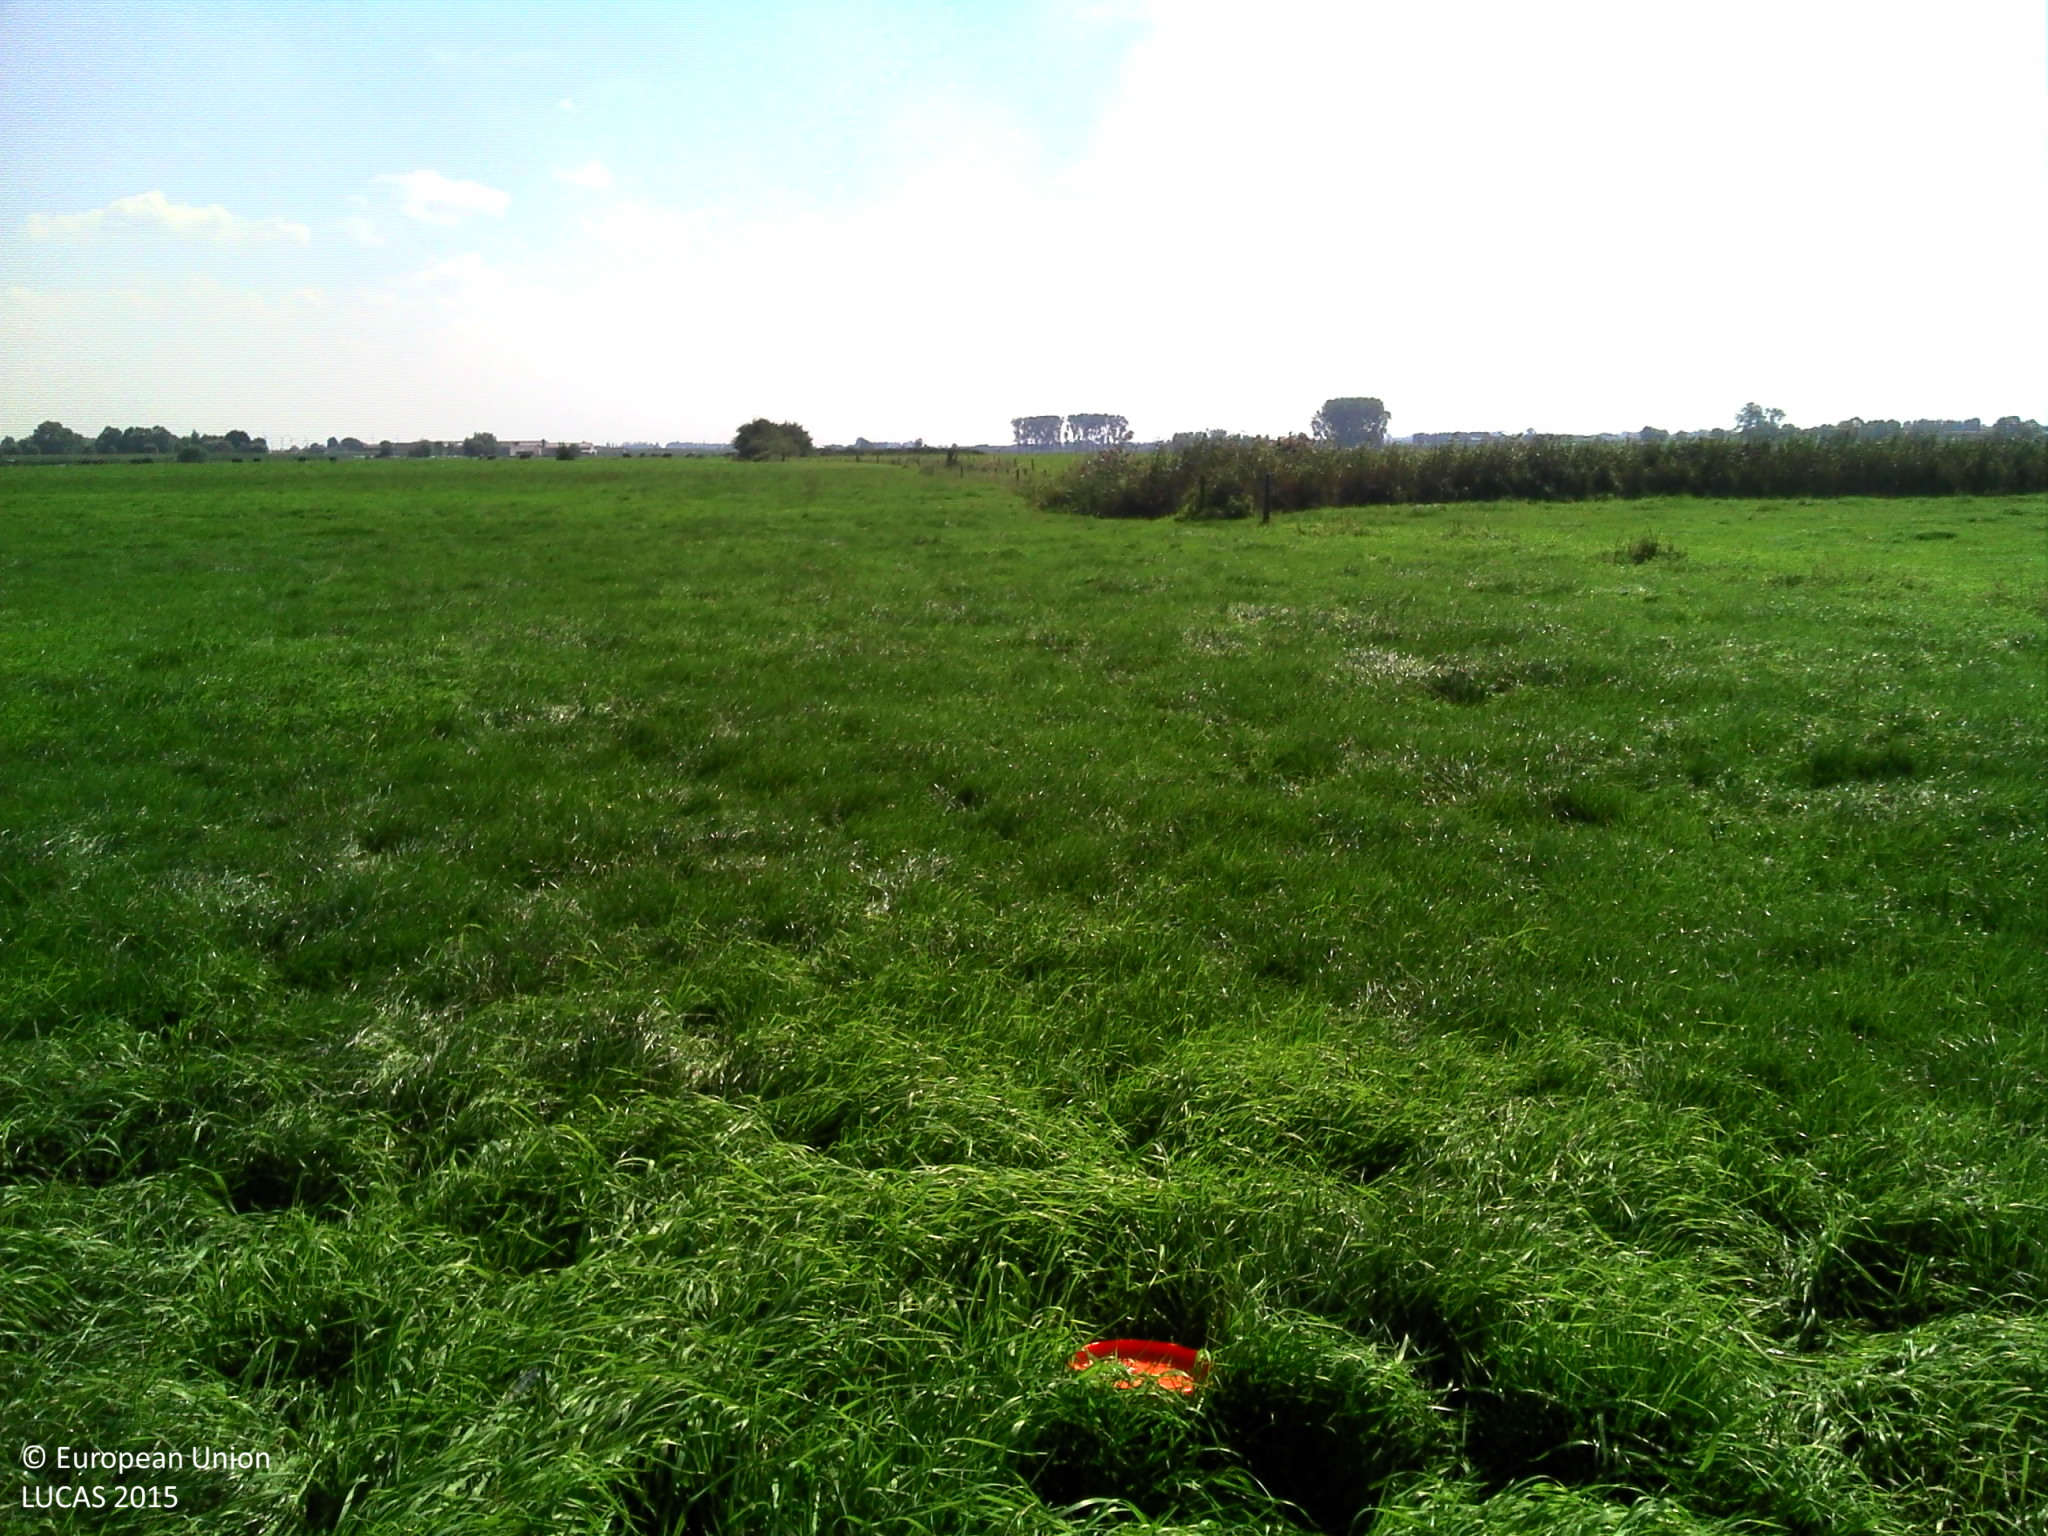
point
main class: Grassland
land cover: Grassland without tree/shrub cover
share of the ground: > 75 %
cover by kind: herbaceous plants 100 %
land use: Agriculture (excluding fallow land and kitchen gardens)
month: September
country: BE
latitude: 50.9494
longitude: 2.8006
